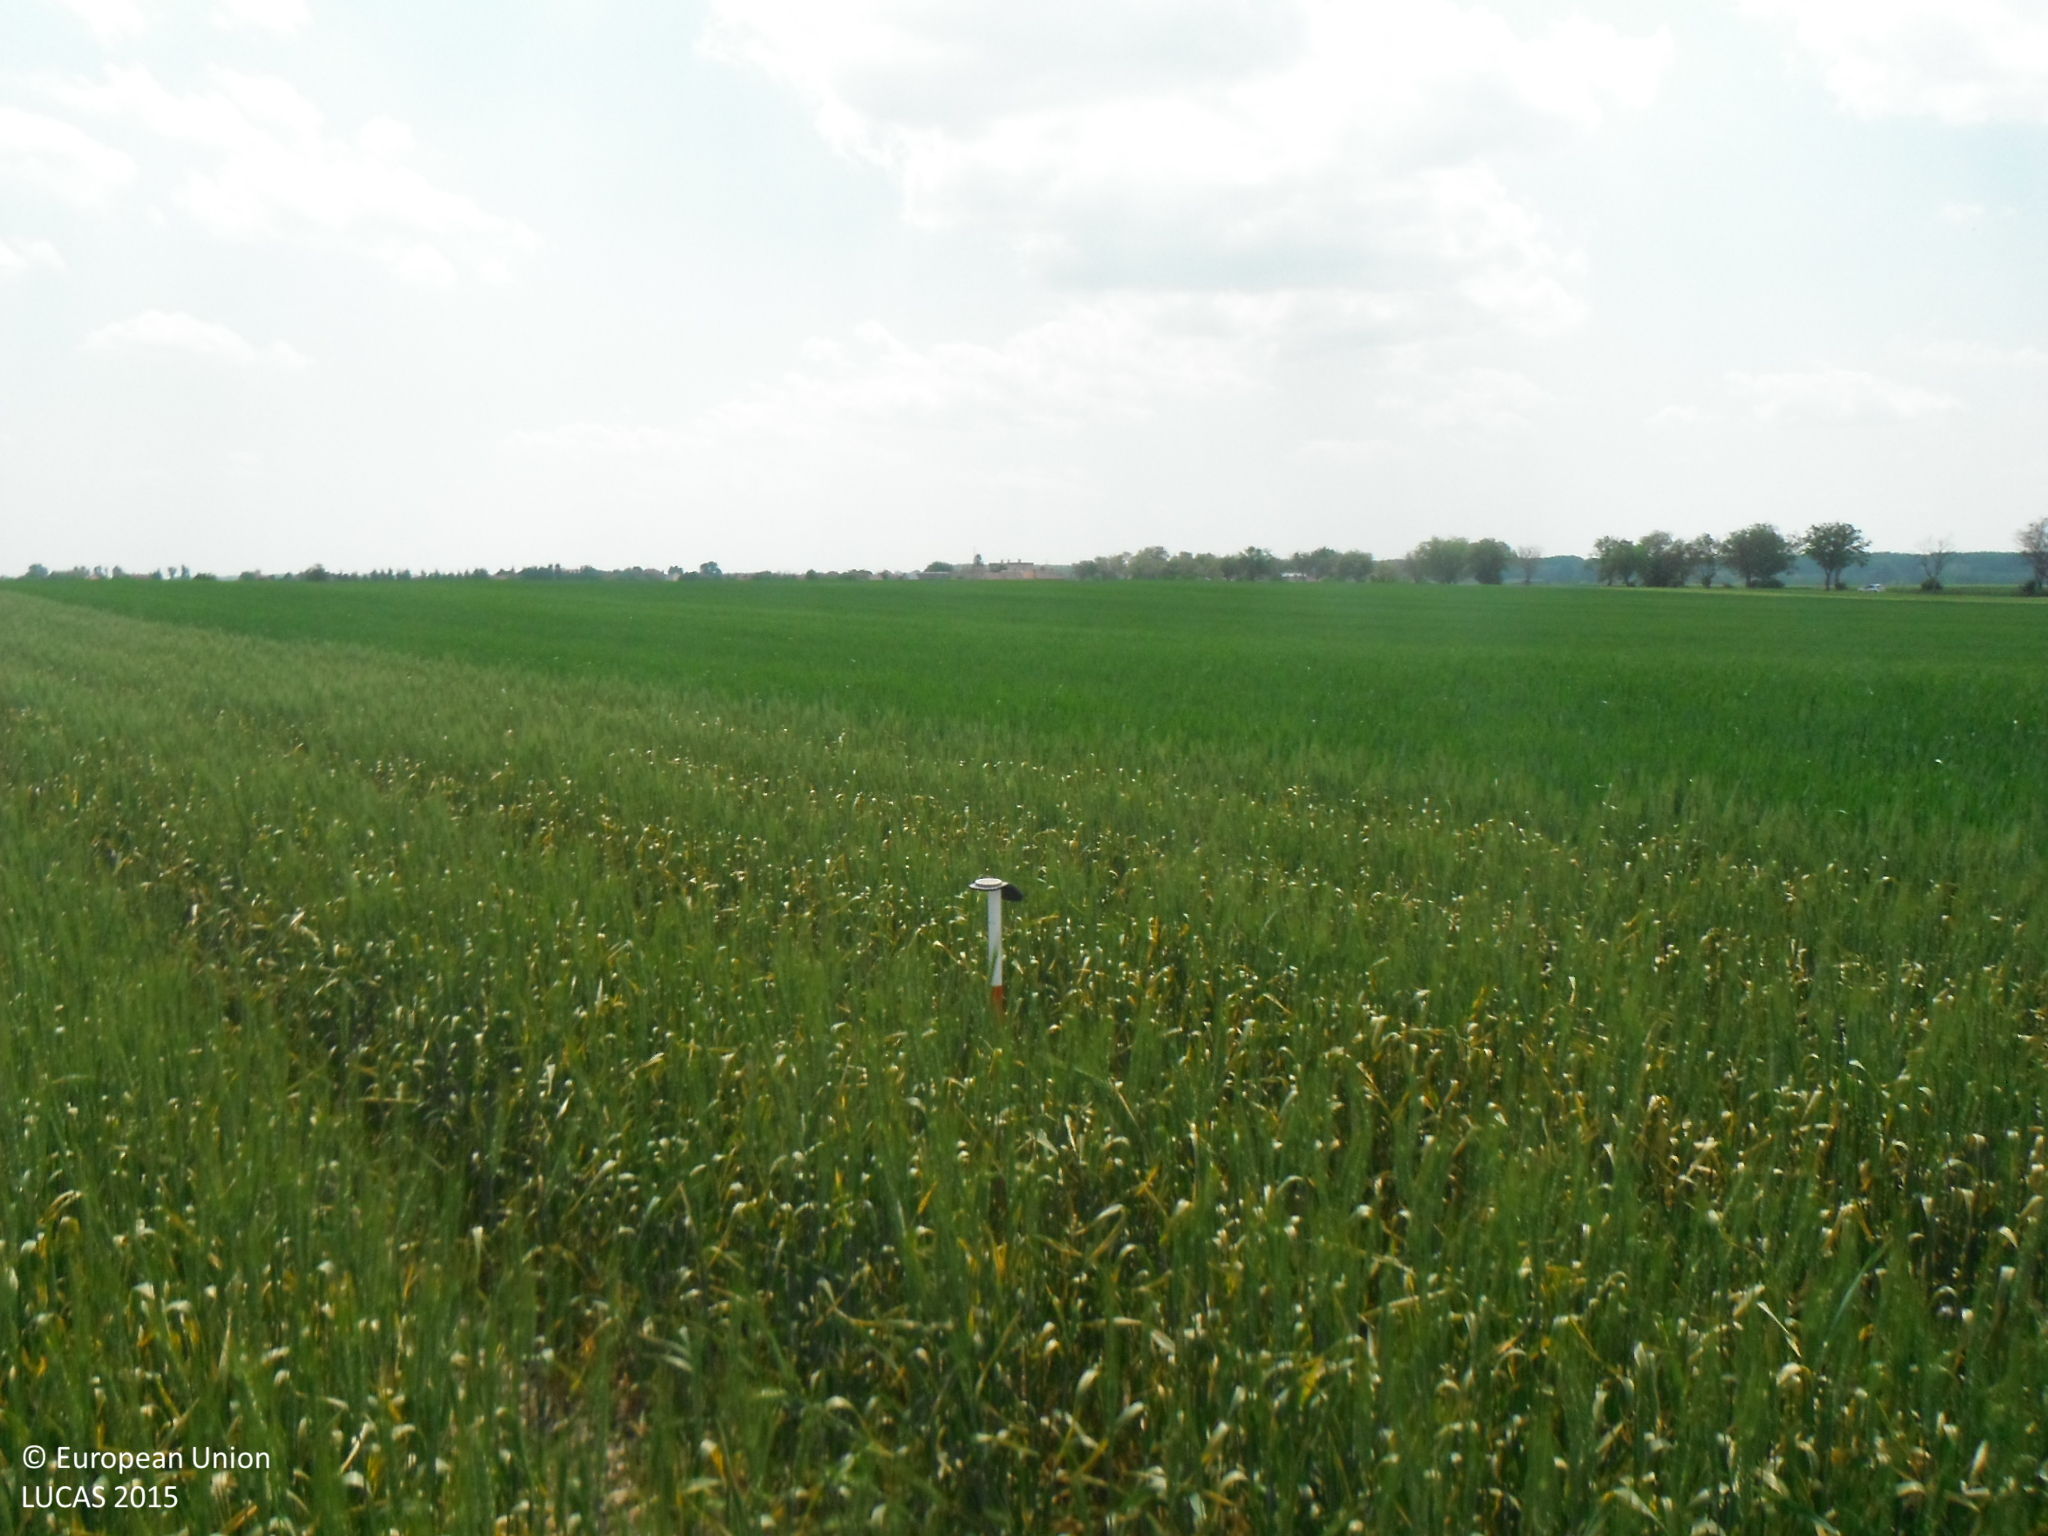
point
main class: Cropland
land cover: Common wheat
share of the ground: > 75 %
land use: Agriculture (excluding fallow land and kitchen gardens)
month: May
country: SK
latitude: 48.0230
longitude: 17.7476
